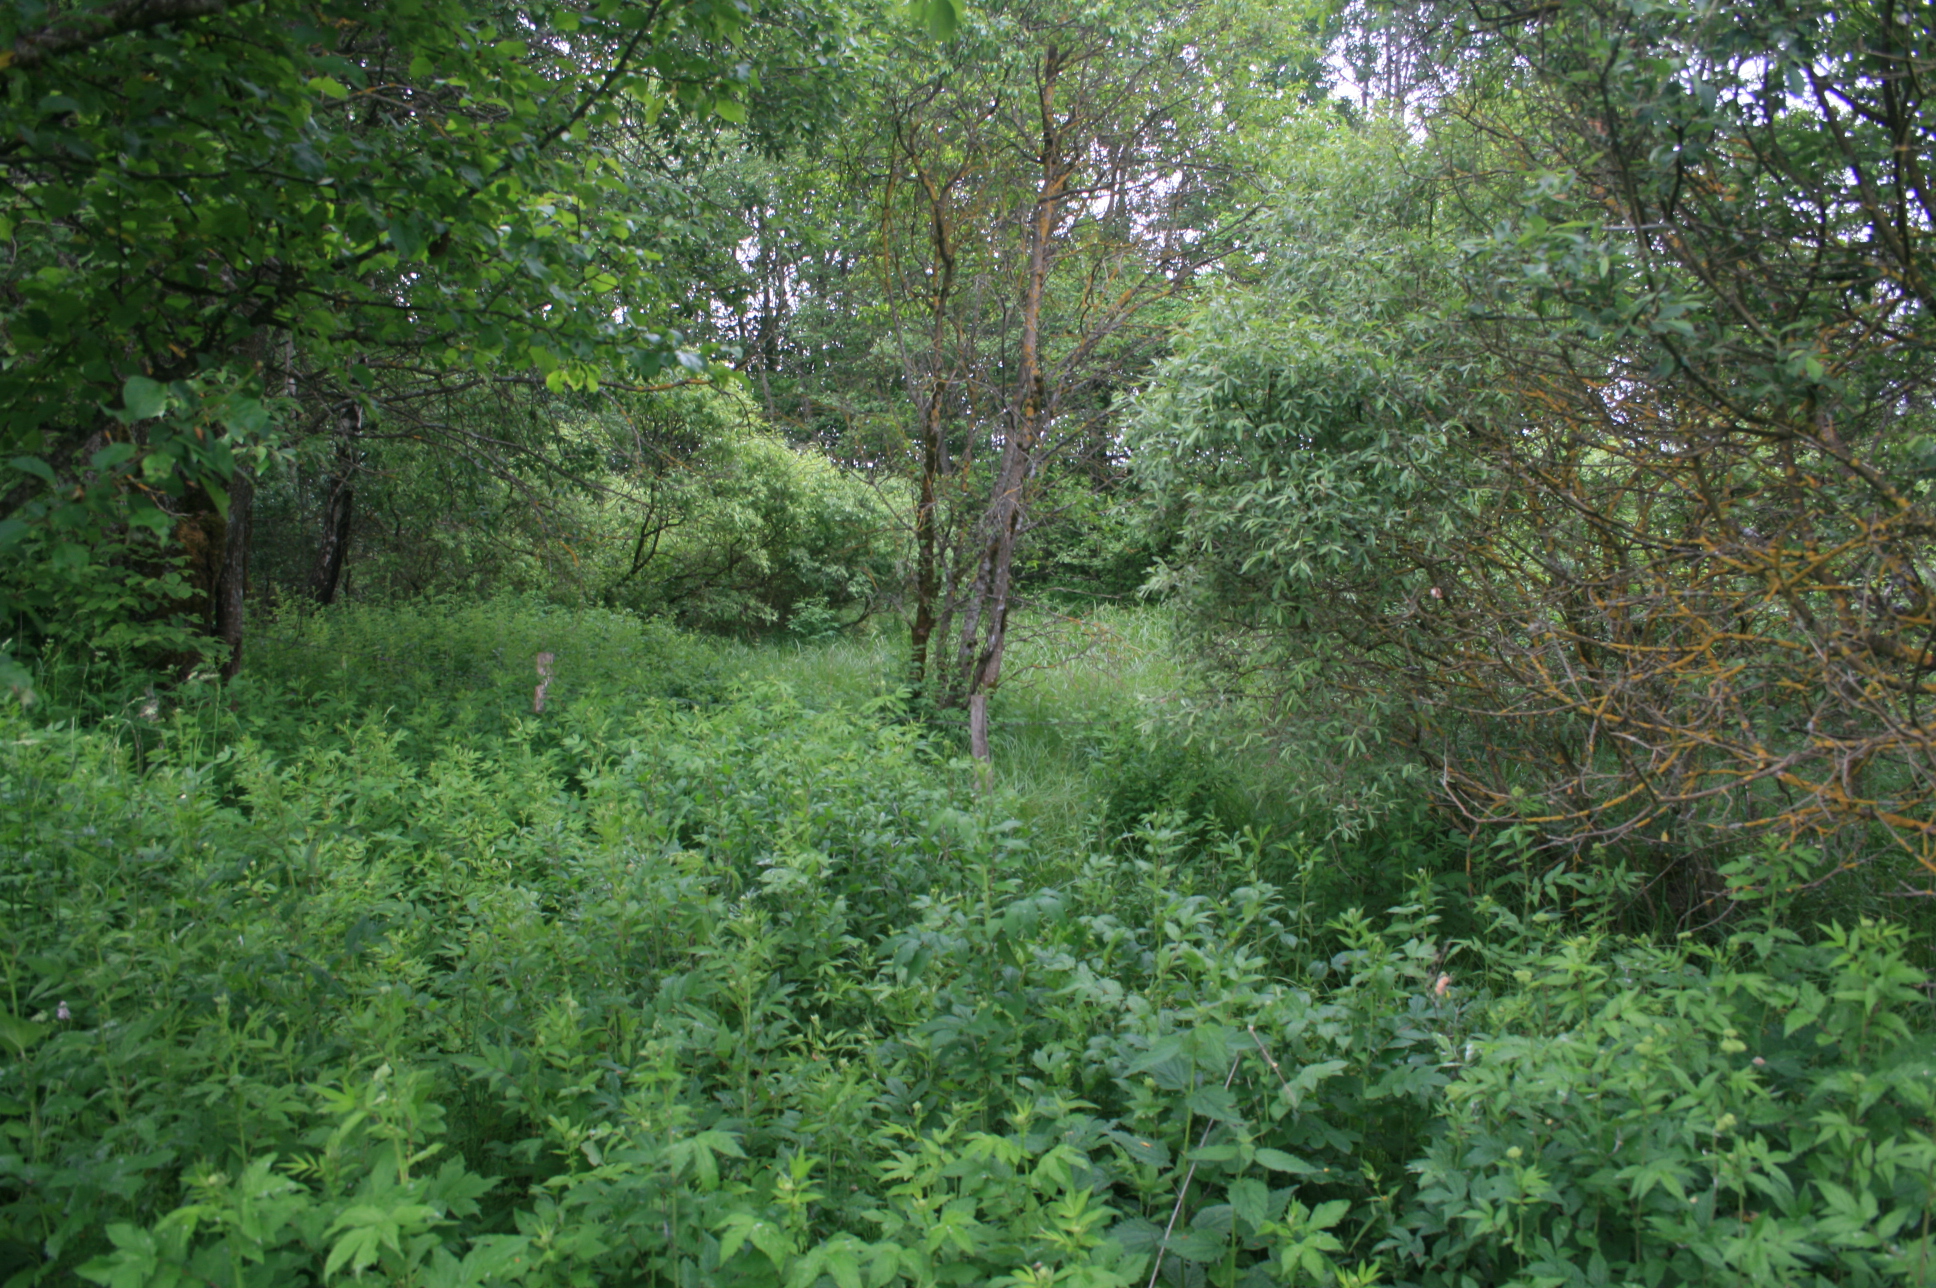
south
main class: Woodland
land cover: Broadleaved woodland
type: non-riverine alder, birch or aspen forest
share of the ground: > 75 %
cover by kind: broadleaved forest trees 90 %, herbaceous plants 10 %
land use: Semi-natural and natural areas not in use
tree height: > 5 m
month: June
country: LT
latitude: 55.7062
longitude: 22.2625
